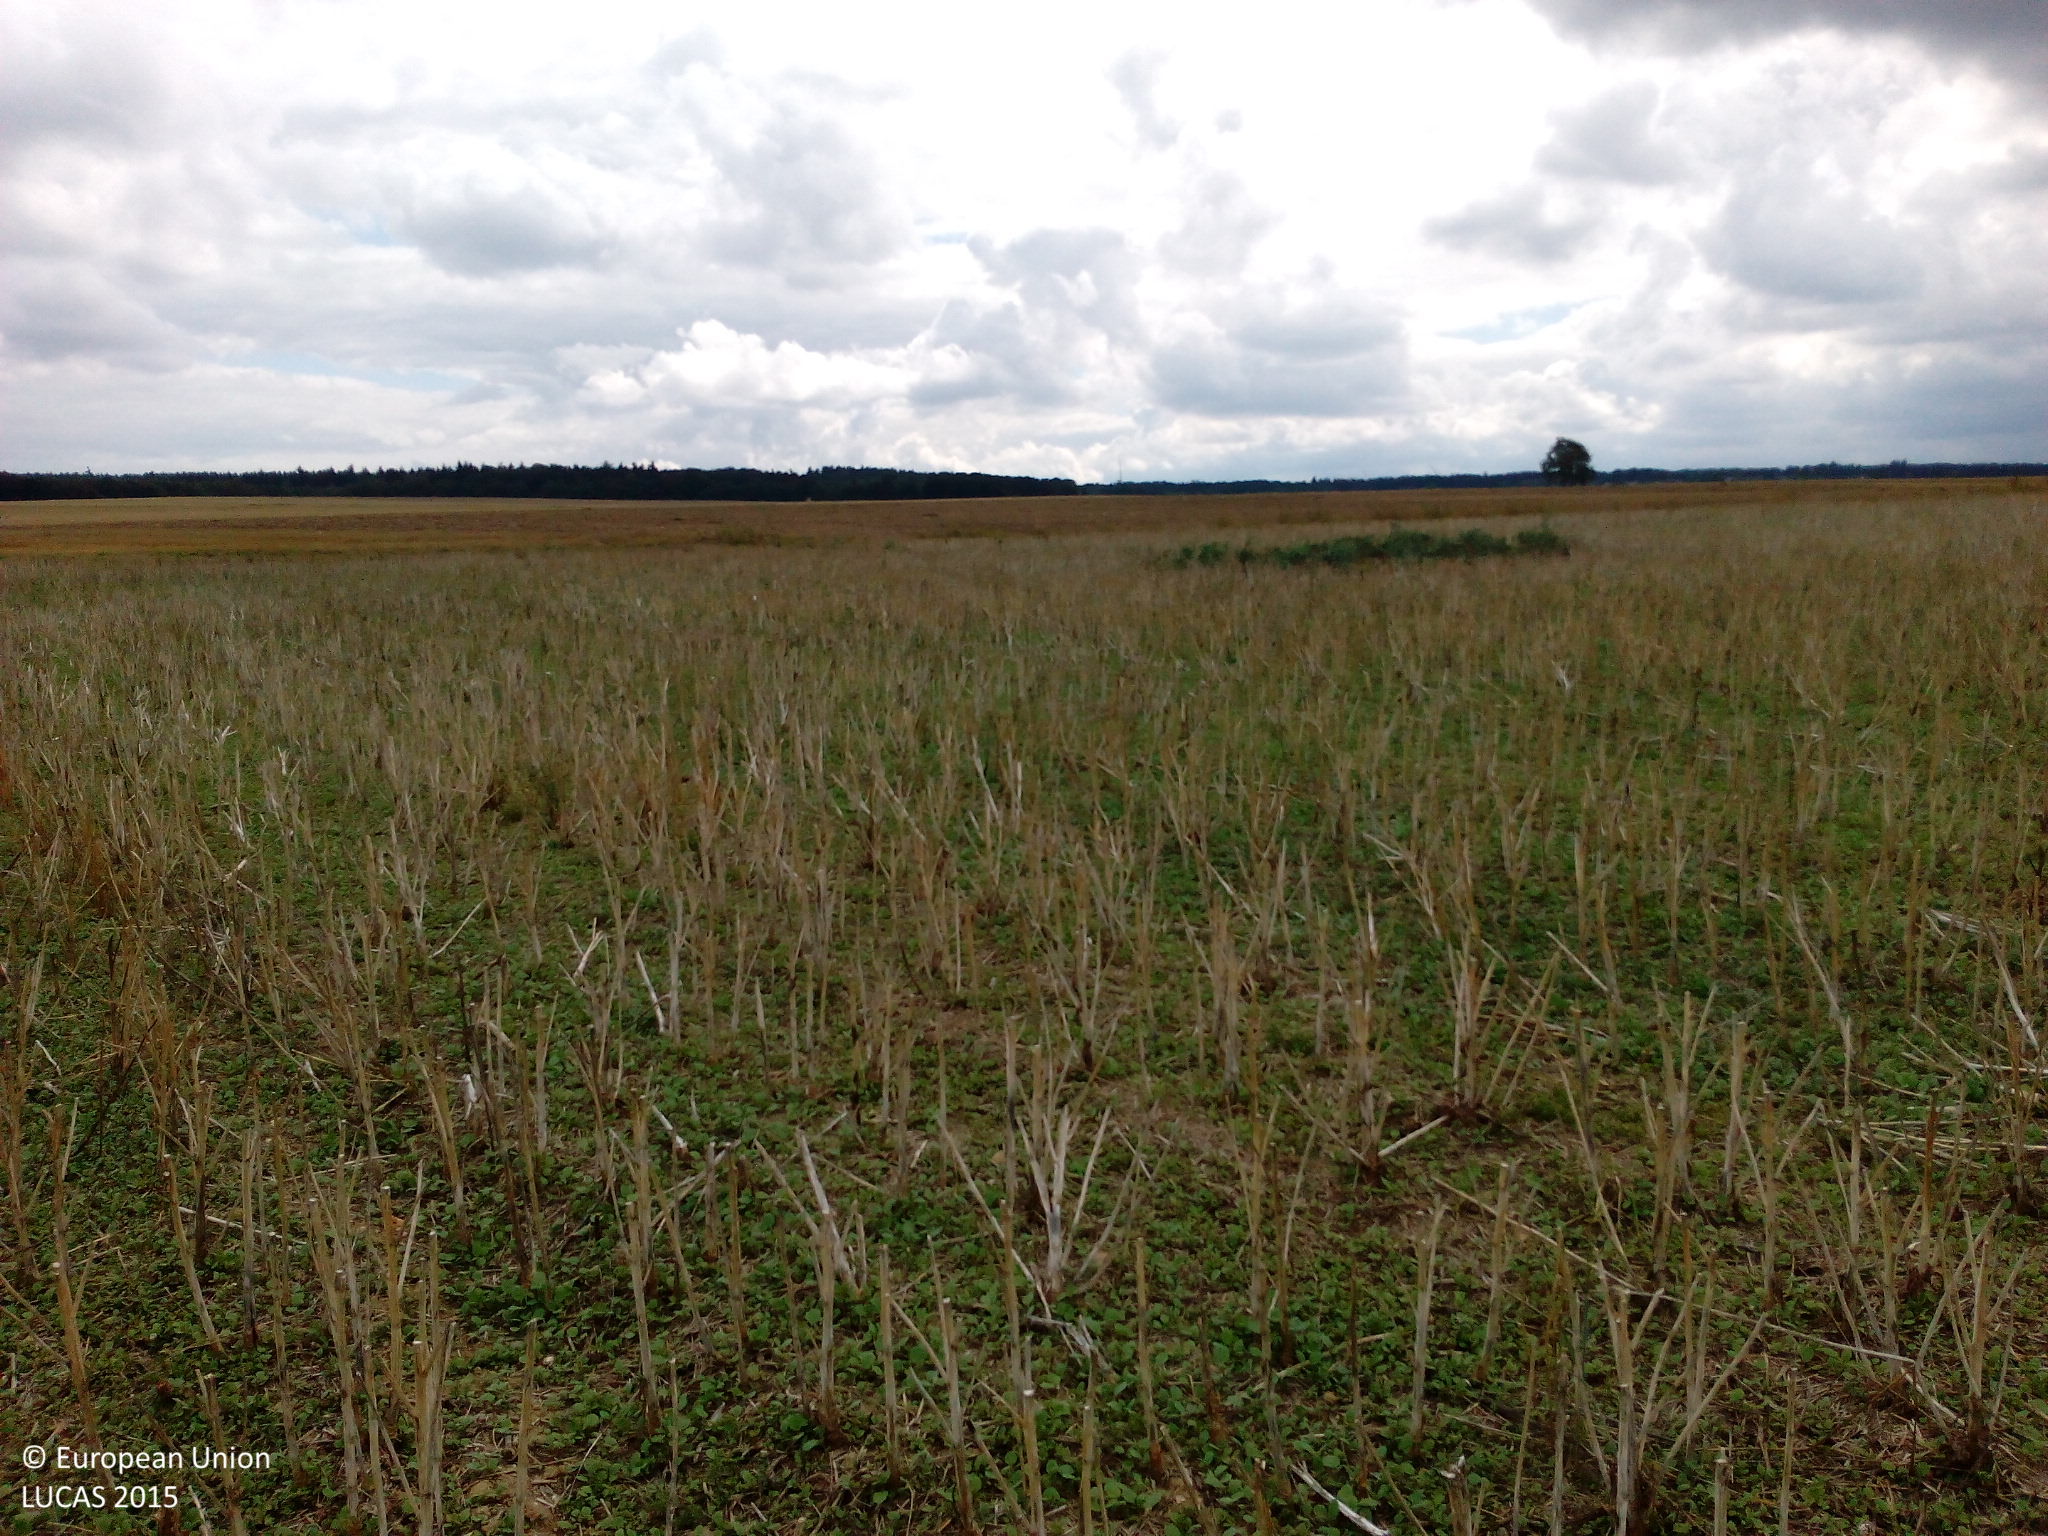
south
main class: Cropland
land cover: Rape and turnip rape
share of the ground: < 10 %
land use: Agriculture (excluding fallow land and kitchen gardens)
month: August
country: DE
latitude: 50.0849
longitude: 7.4986
